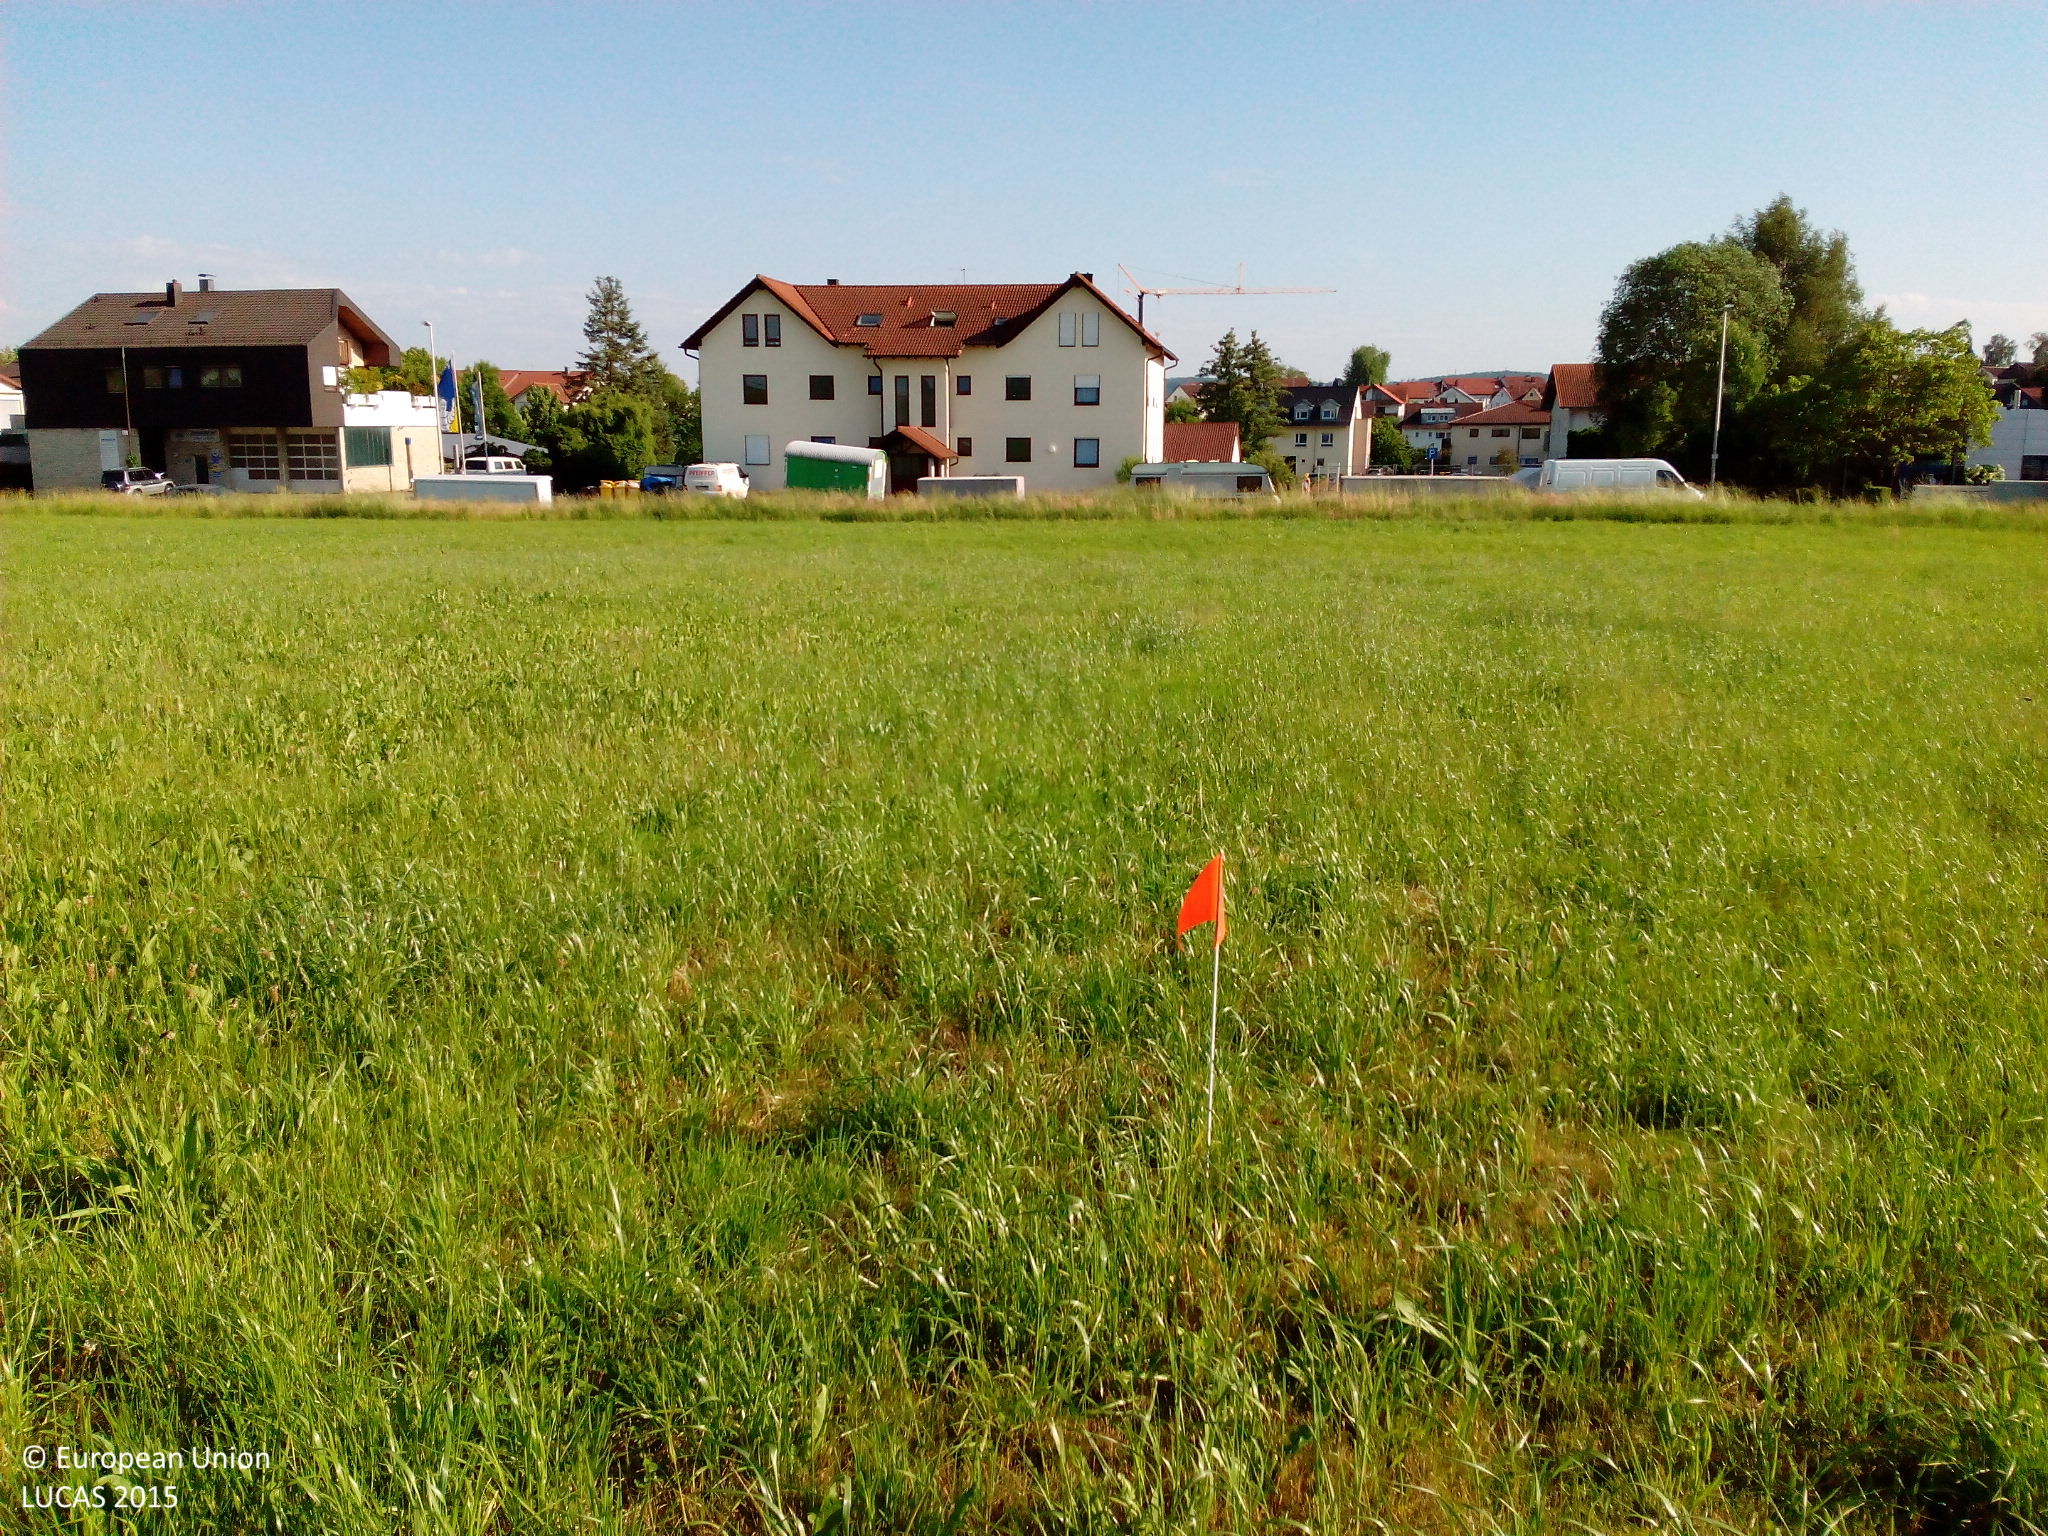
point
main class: Grassland
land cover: Grassland without tree/shrub cover
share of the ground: > 75 %
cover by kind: herbaceous plants 100 %
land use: Agriculture (excluding fallow land and kitchen gardens)
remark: Harvested field
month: June
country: DE
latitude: 48.9057
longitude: 9.4136
